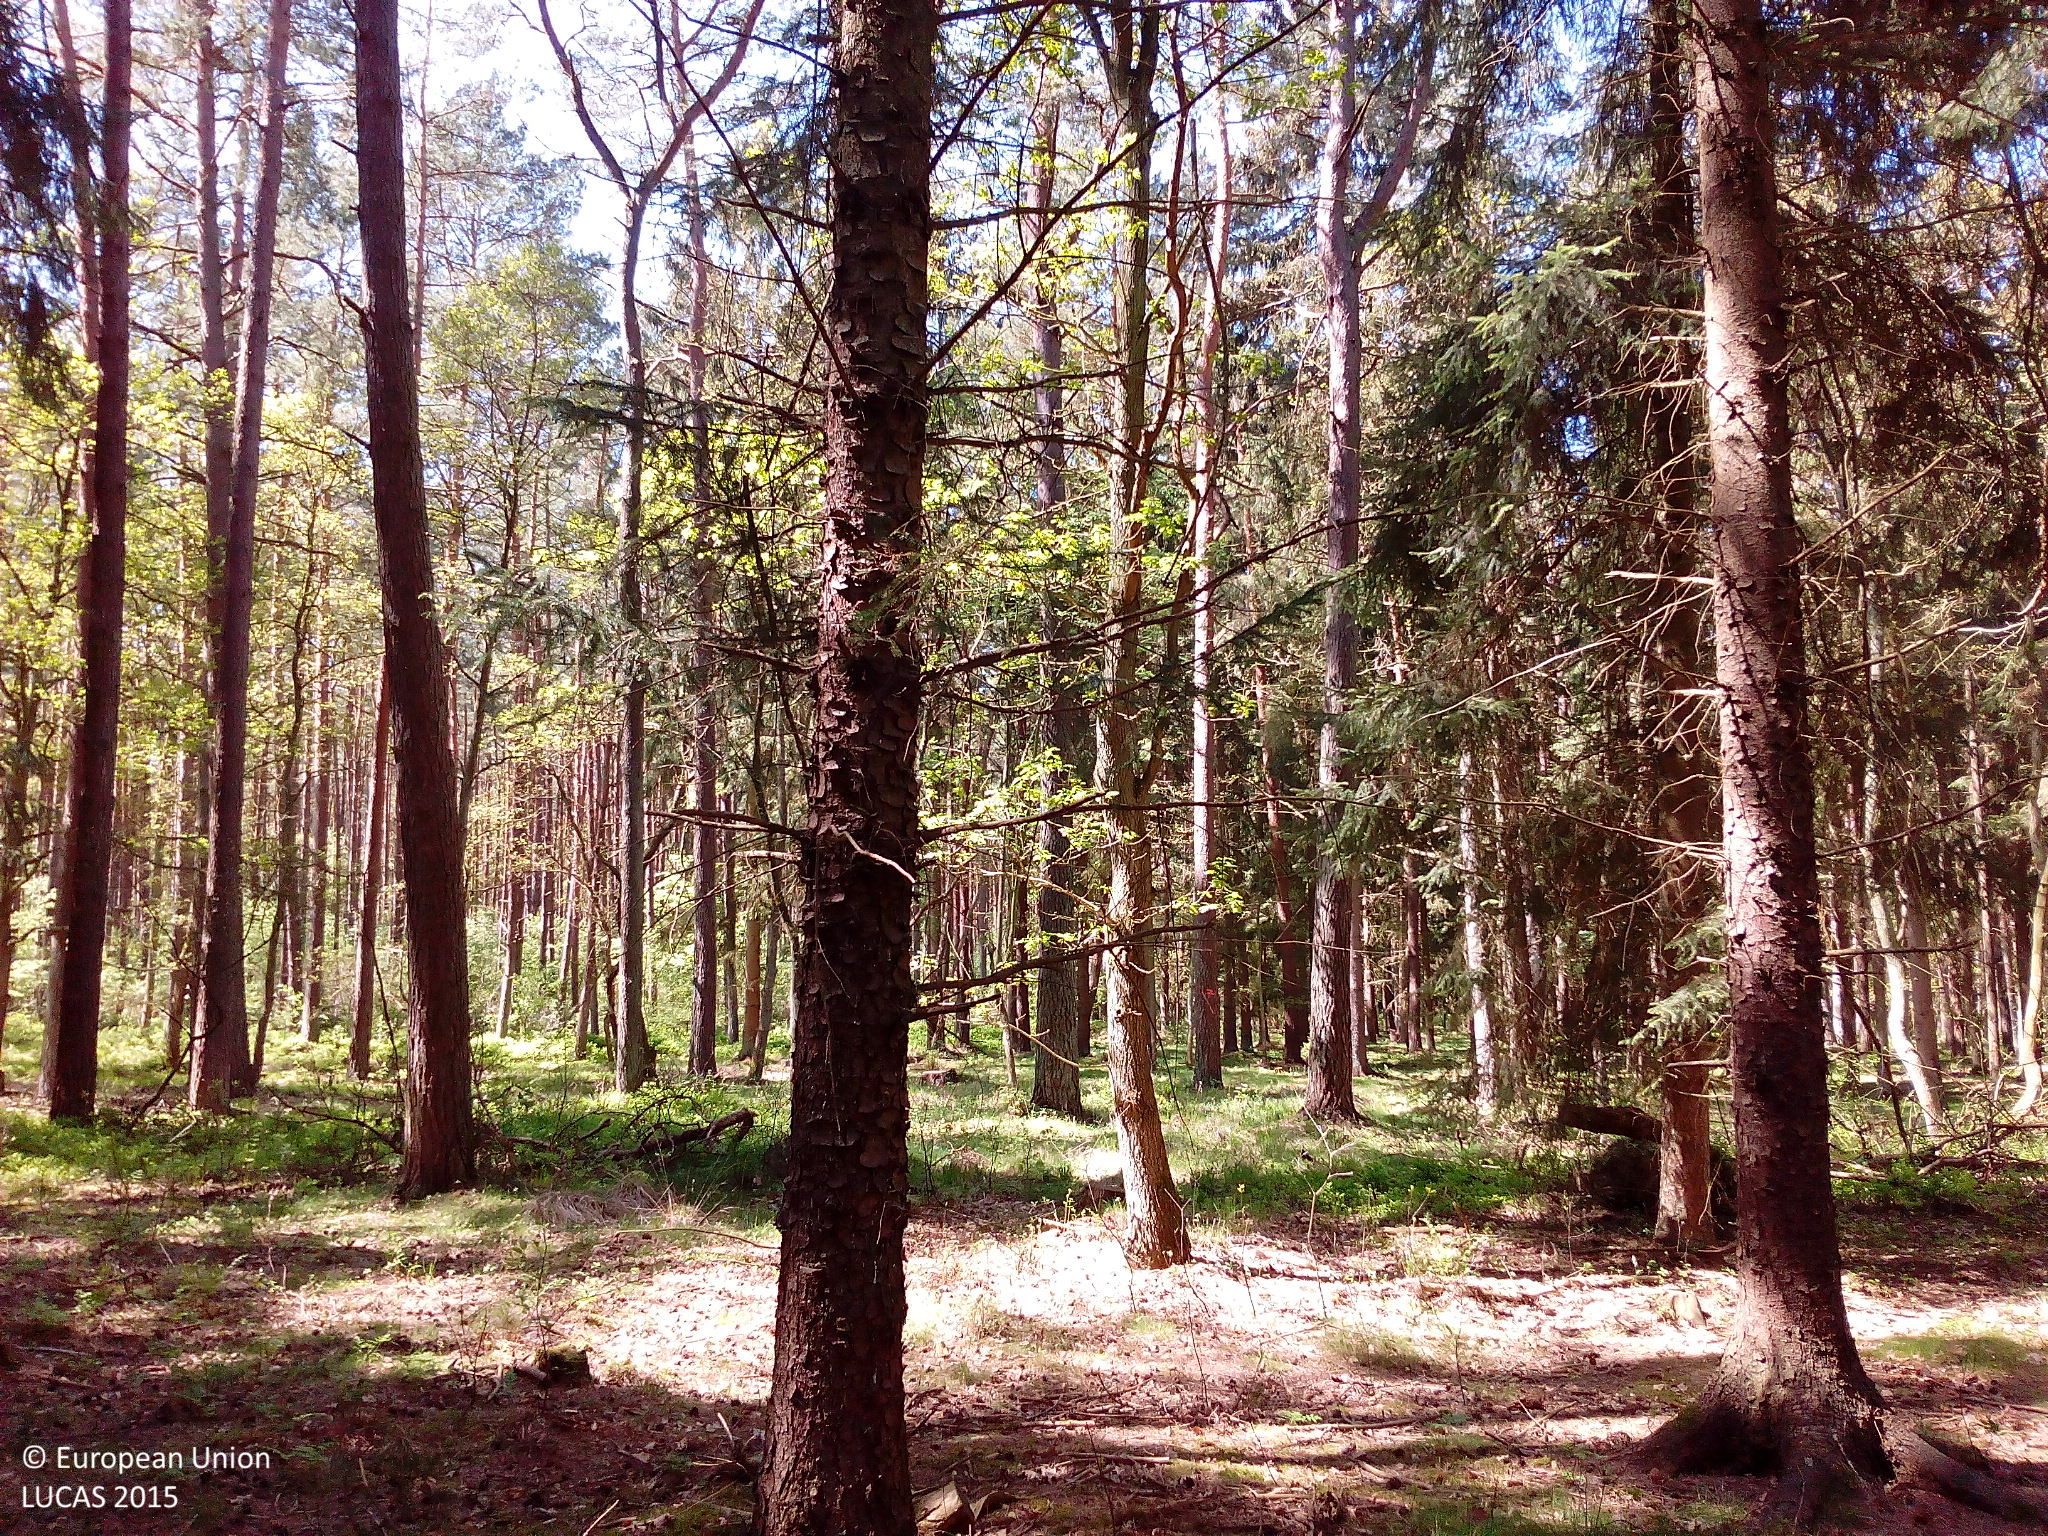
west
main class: Woodland
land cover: Other coniferous woodland
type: mesophytic deciduous forest
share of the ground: > 75 %
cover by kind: coniferous forest trees 75 %, broadleaved forest trees 20 %, lichens and mosses 5 %
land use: Forestry
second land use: Amenities, museums, leisure
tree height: > 5 m
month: May
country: DE
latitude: 54.3624
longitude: 12.6306
